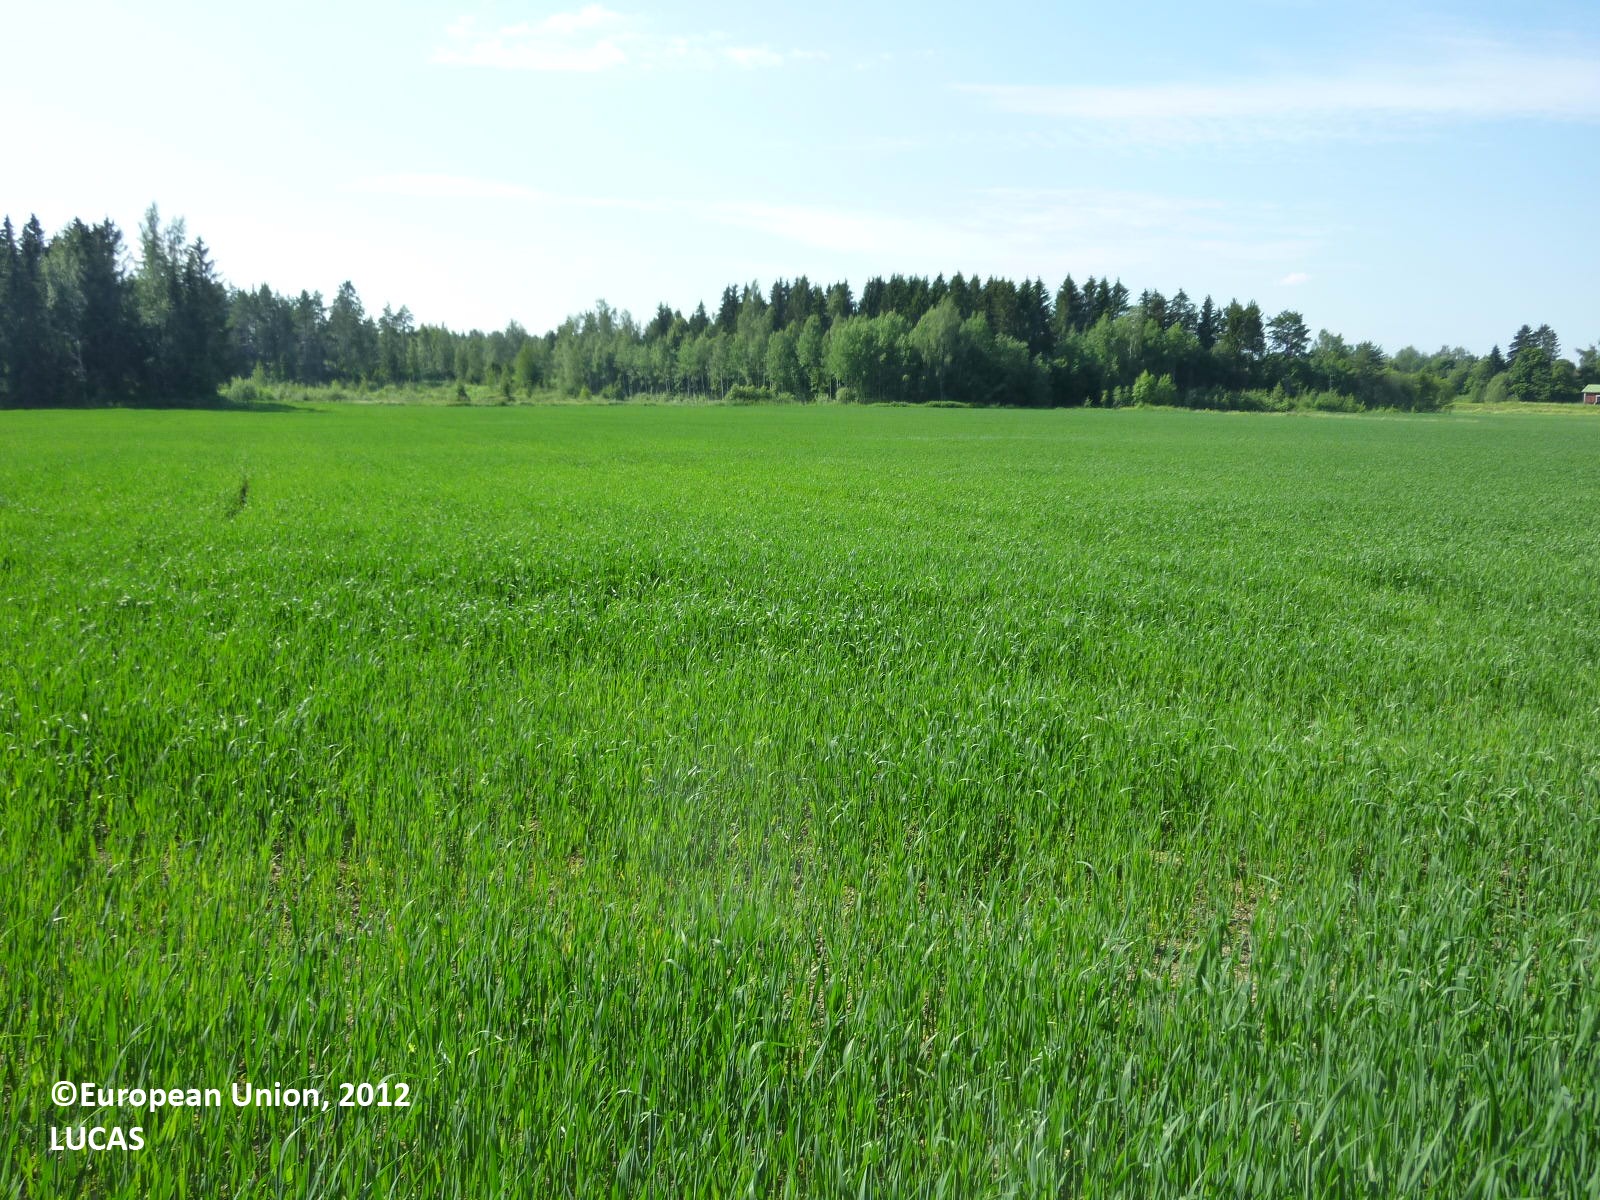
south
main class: Cropland
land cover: Oats
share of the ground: > 75 %
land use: Agriculture (excluding fallow land and kitchen gardens)
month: July
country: FI
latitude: 61.2931
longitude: 22.3997
